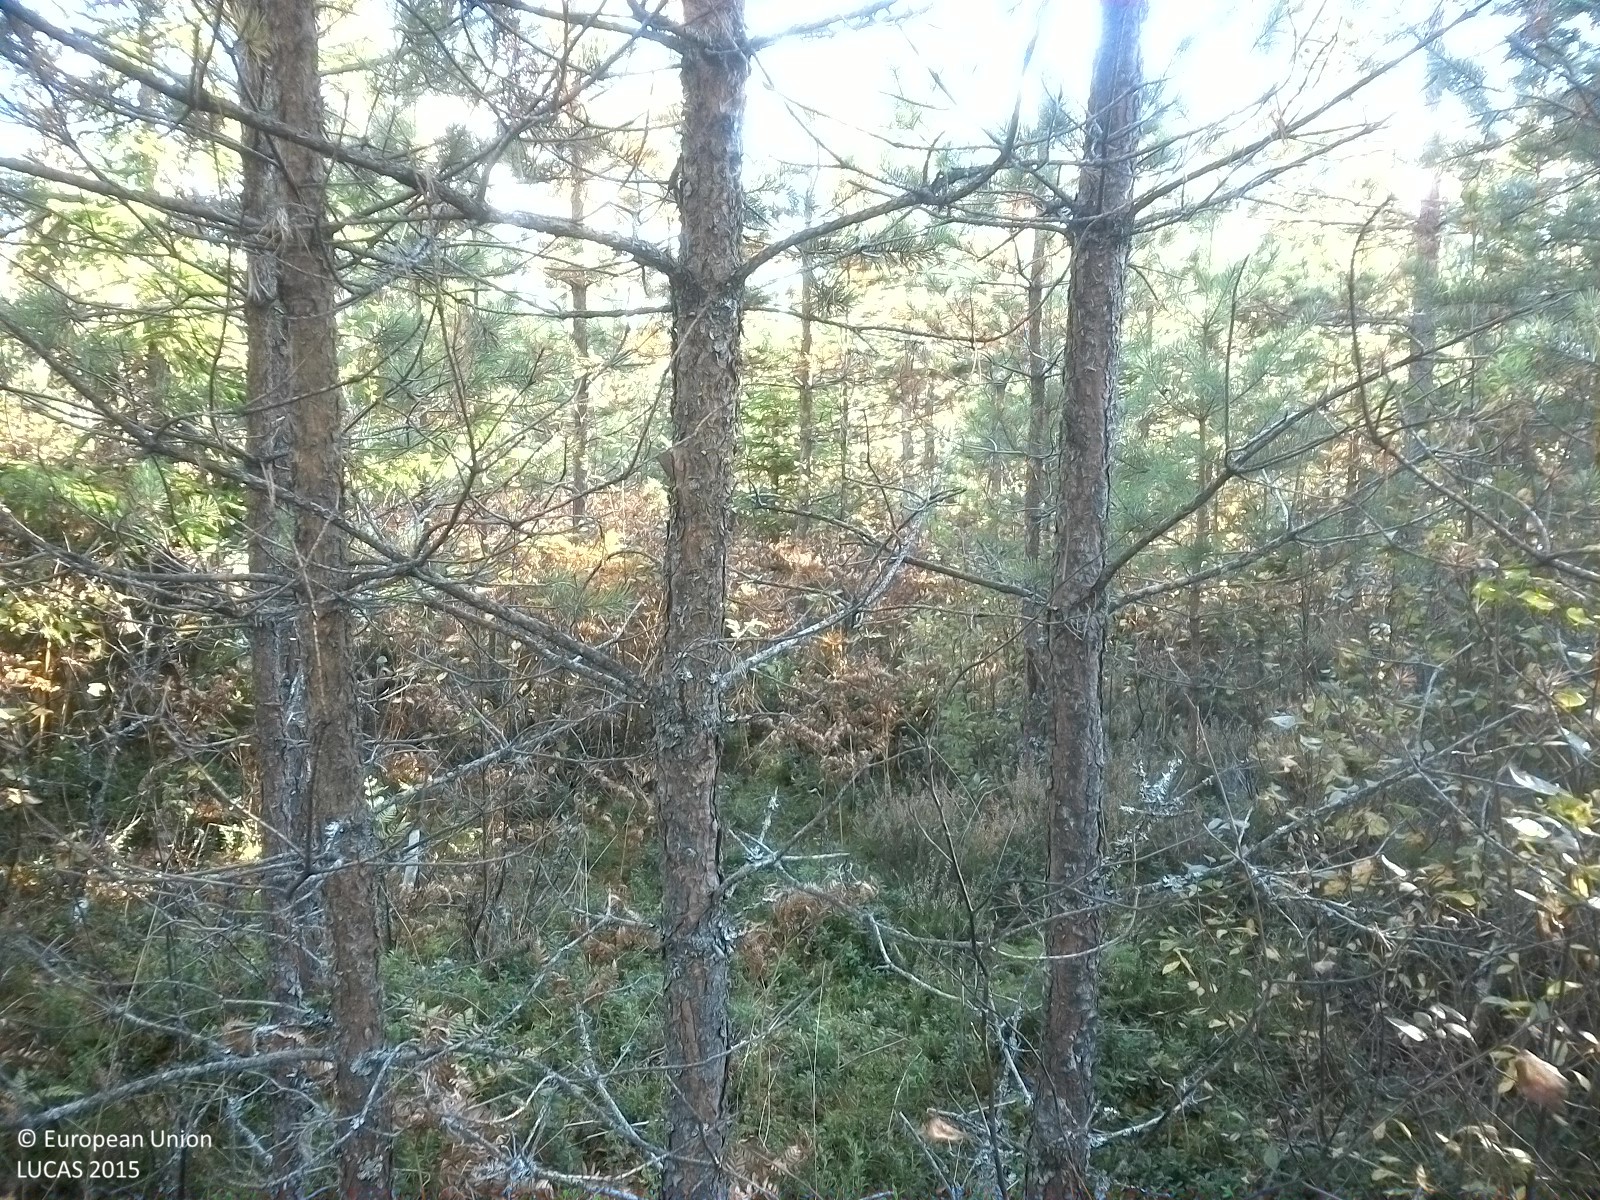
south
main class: Woodland
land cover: Pine dominated coniferous woodland
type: boreal forest
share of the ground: 50 - 75 %
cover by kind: coniferous forest trees 55 %, herbaceous plants 20 %, shrubs 15 %, broadleaved forest trees 5 %, lichens and mosses 5 %
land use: Forestry
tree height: < 5 m
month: September
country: SE
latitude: 58.7904
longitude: 15.5474
